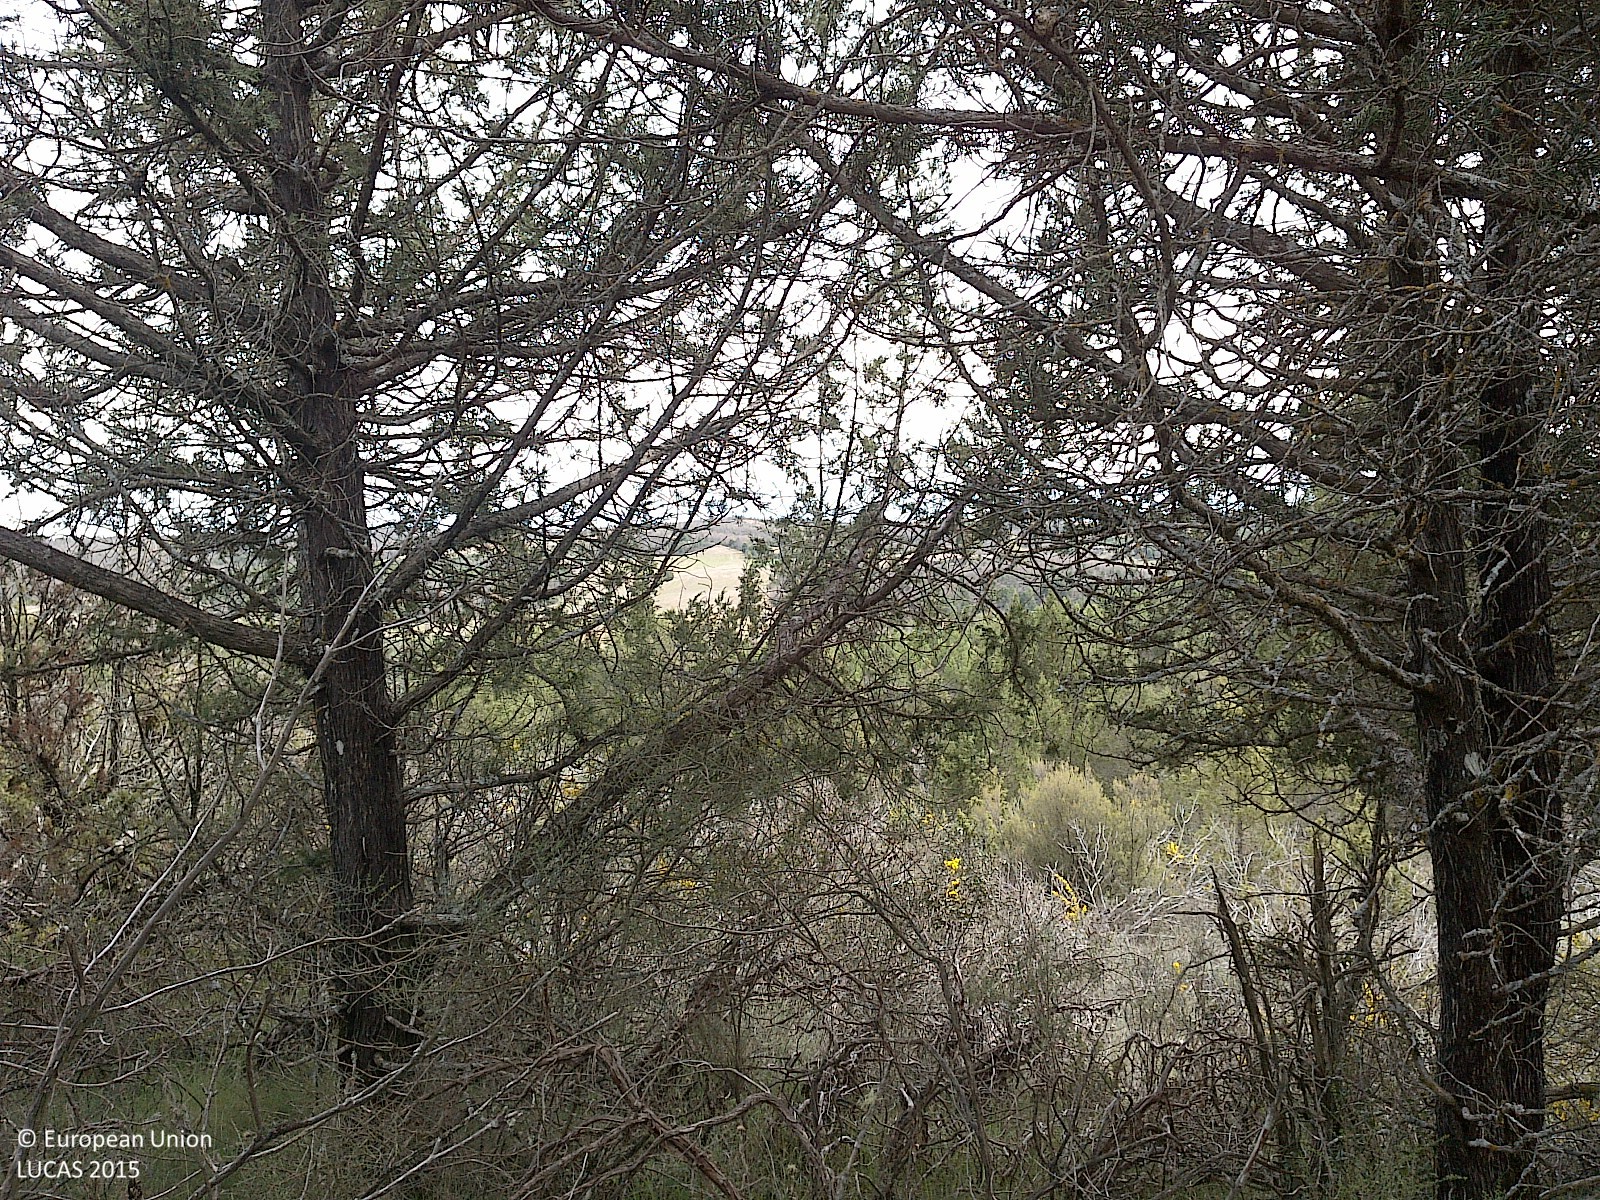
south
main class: Woodland
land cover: Other coniferous woodland
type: coniferous forest of the mediterranean region
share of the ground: 25 - 50 %
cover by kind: shrubs 65 %, coniferous forest trees 30 %, herbaceous plants 5 %
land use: Semi-natural and natural areas not in use
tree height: > 5 m
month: April
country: ES
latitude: 41.6982
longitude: -3.0336
